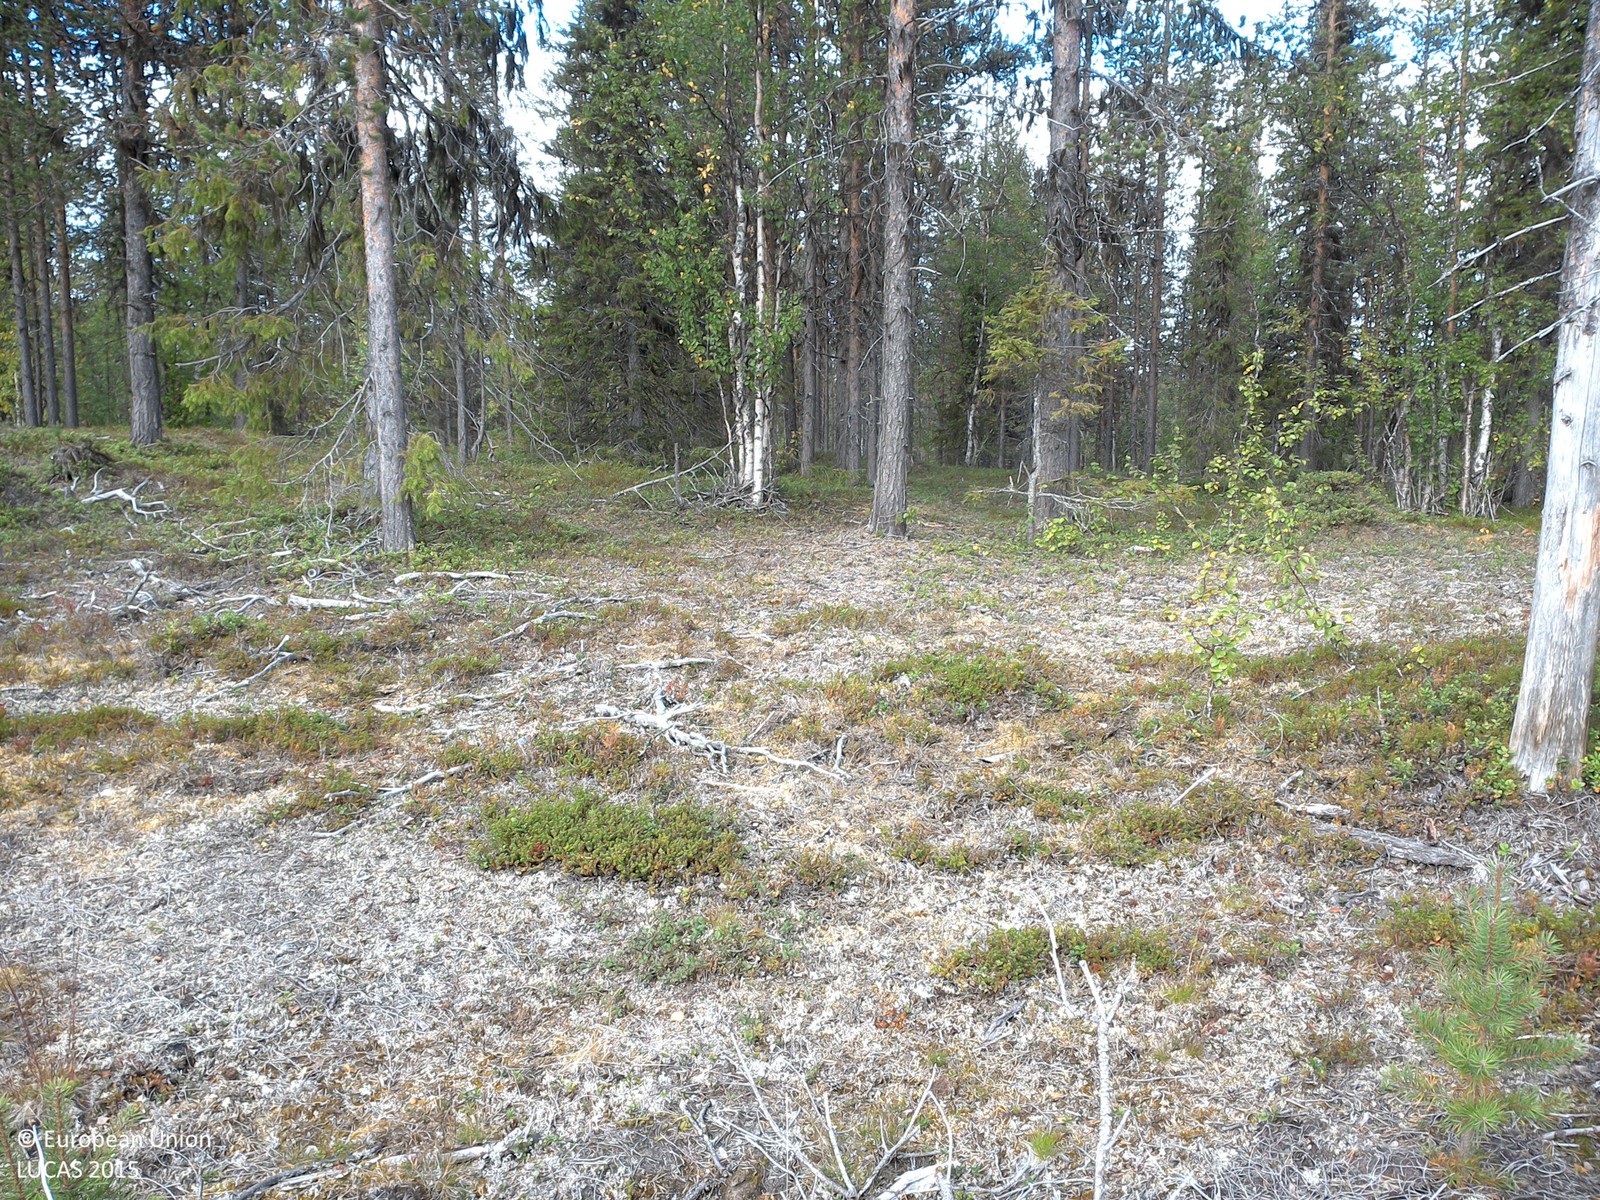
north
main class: Woodland
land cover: Pine dominated mixed woodland
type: boreal forest
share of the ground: 10 - 25 %
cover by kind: herbaceous plants 50 %, shrubs 20 %, lichens and mosses 15 %, coniferous forest trees 5 %, broadleaved forest trees 5 %, consolidated bare surface 5 %
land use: Forestry
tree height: < 5 m
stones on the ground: < 10 %
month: September
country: SE
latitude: 67.8273
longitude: 23.0895
